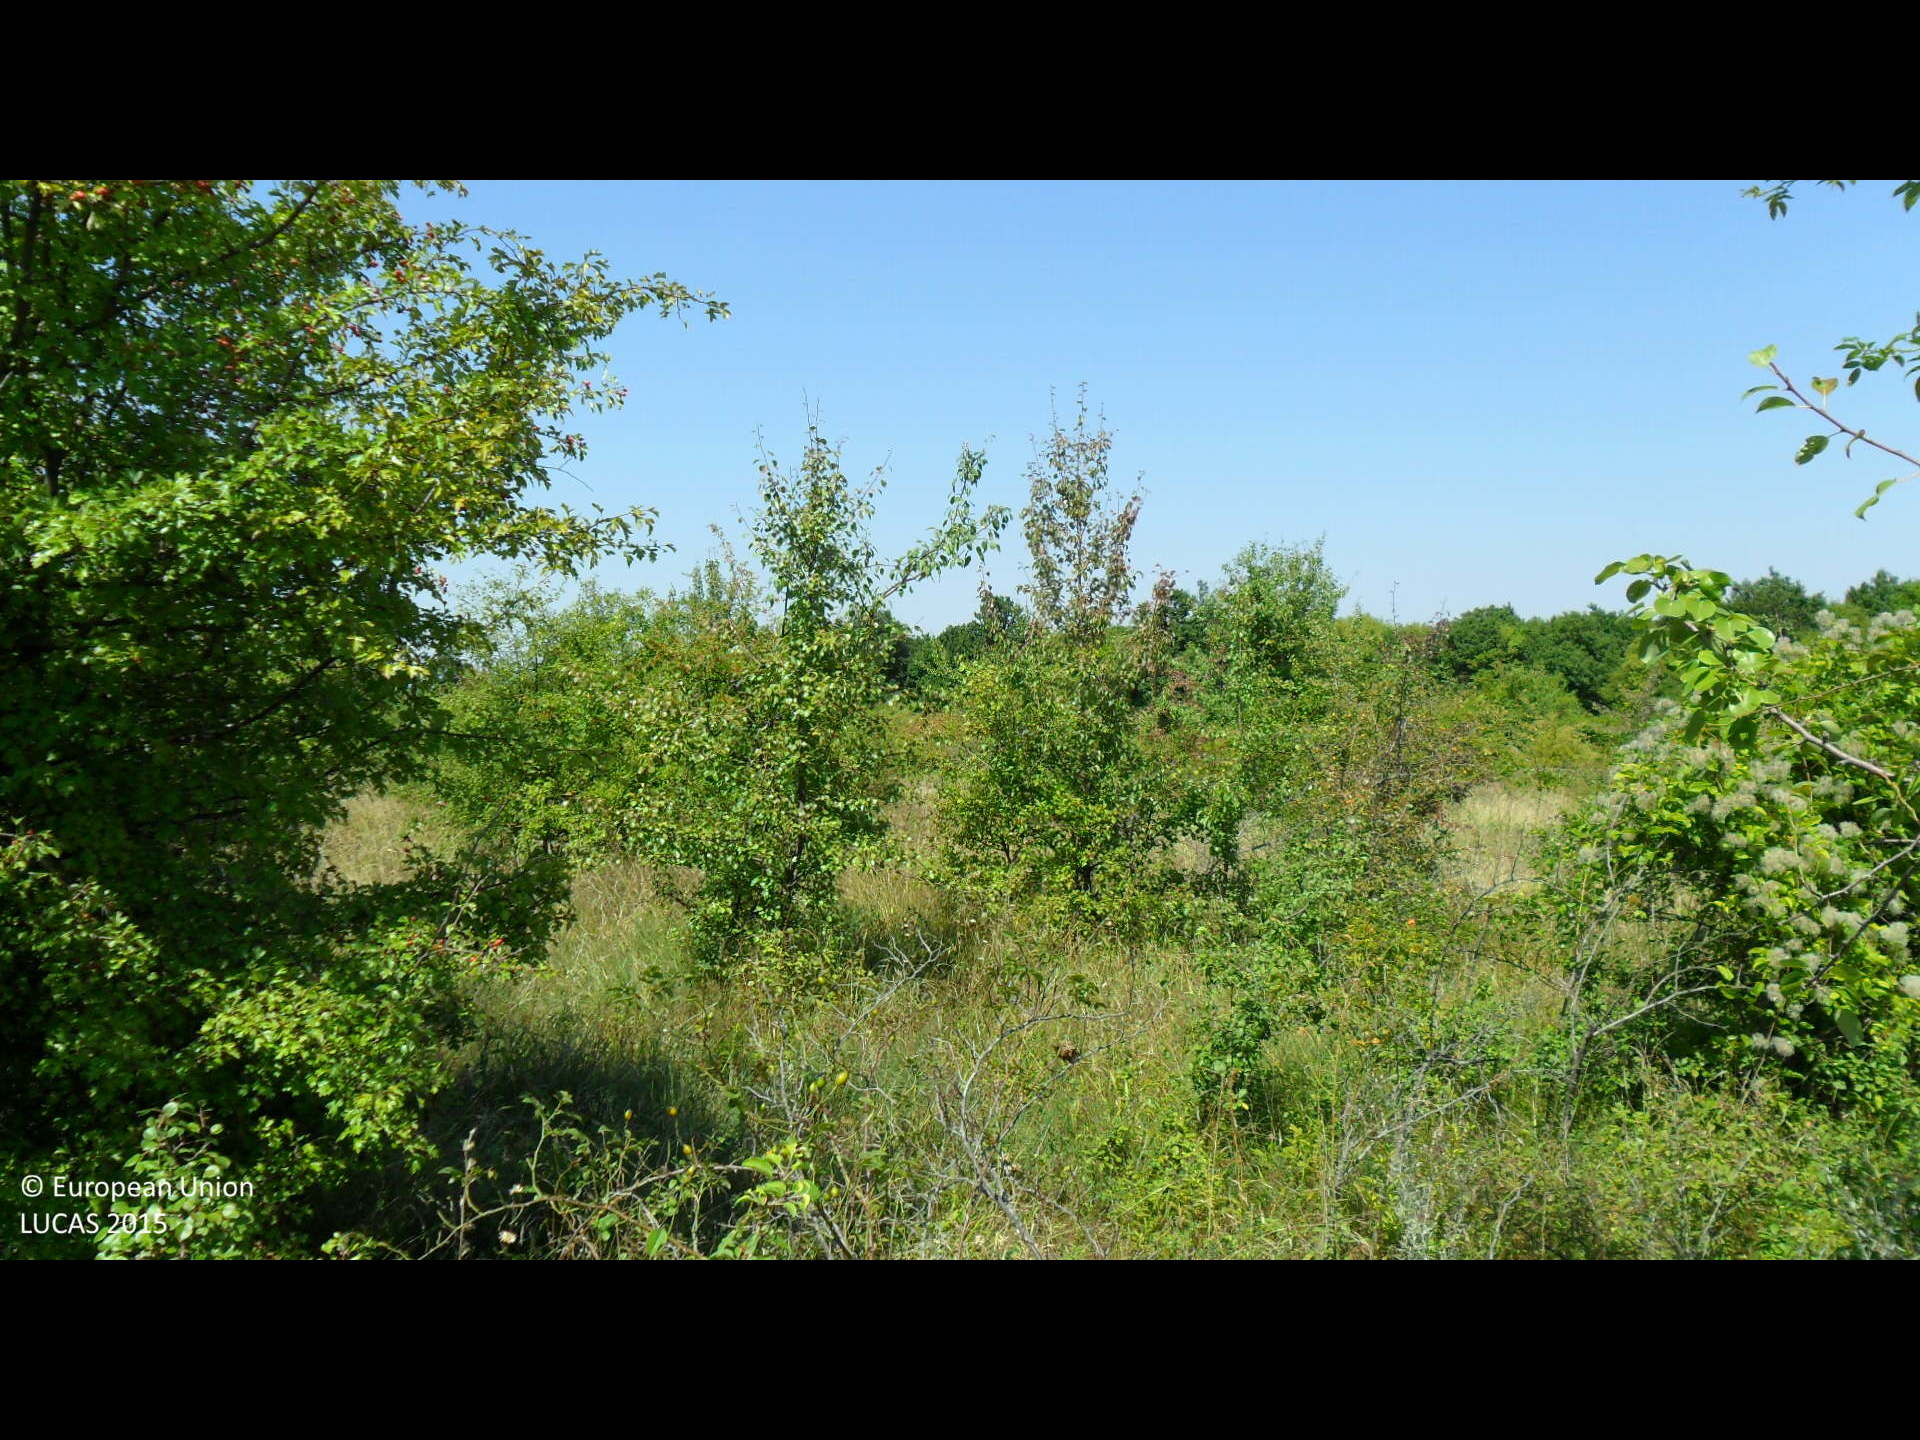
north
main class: Shrubland
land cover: Shrubland without tree cover
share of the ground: > 75 %
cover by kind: shrubs 75 %, herbaceous plants 25 %
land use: Semi-natural and natural areas not in use
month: August
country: BG
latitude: 43.4630
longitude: 26.2526
